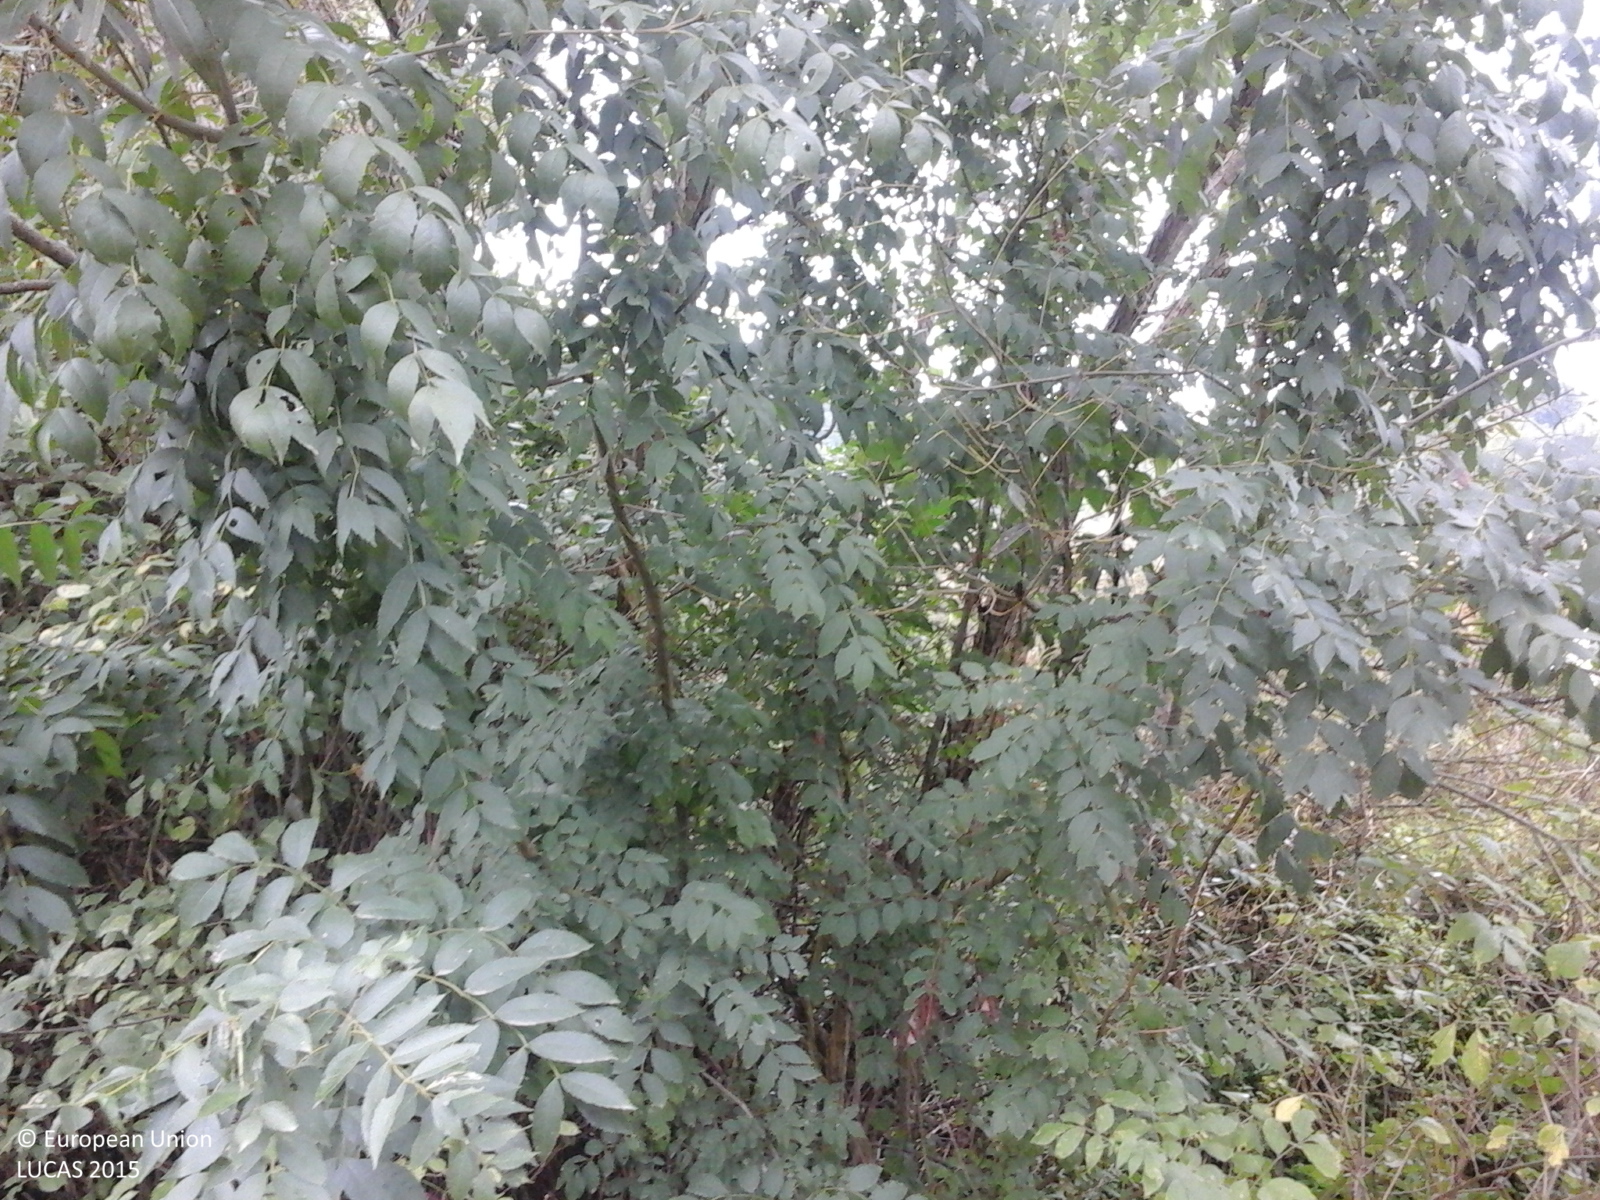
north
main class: Shrubland
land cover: Shrubland with sparse tree cover
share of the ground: > 75 %
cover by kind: shrubs 95 %, broadleaved forest trees 5 %
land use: Semi-natural and natural areas not in use
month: September
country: RO
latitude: 45.9138
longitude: 22.2797
